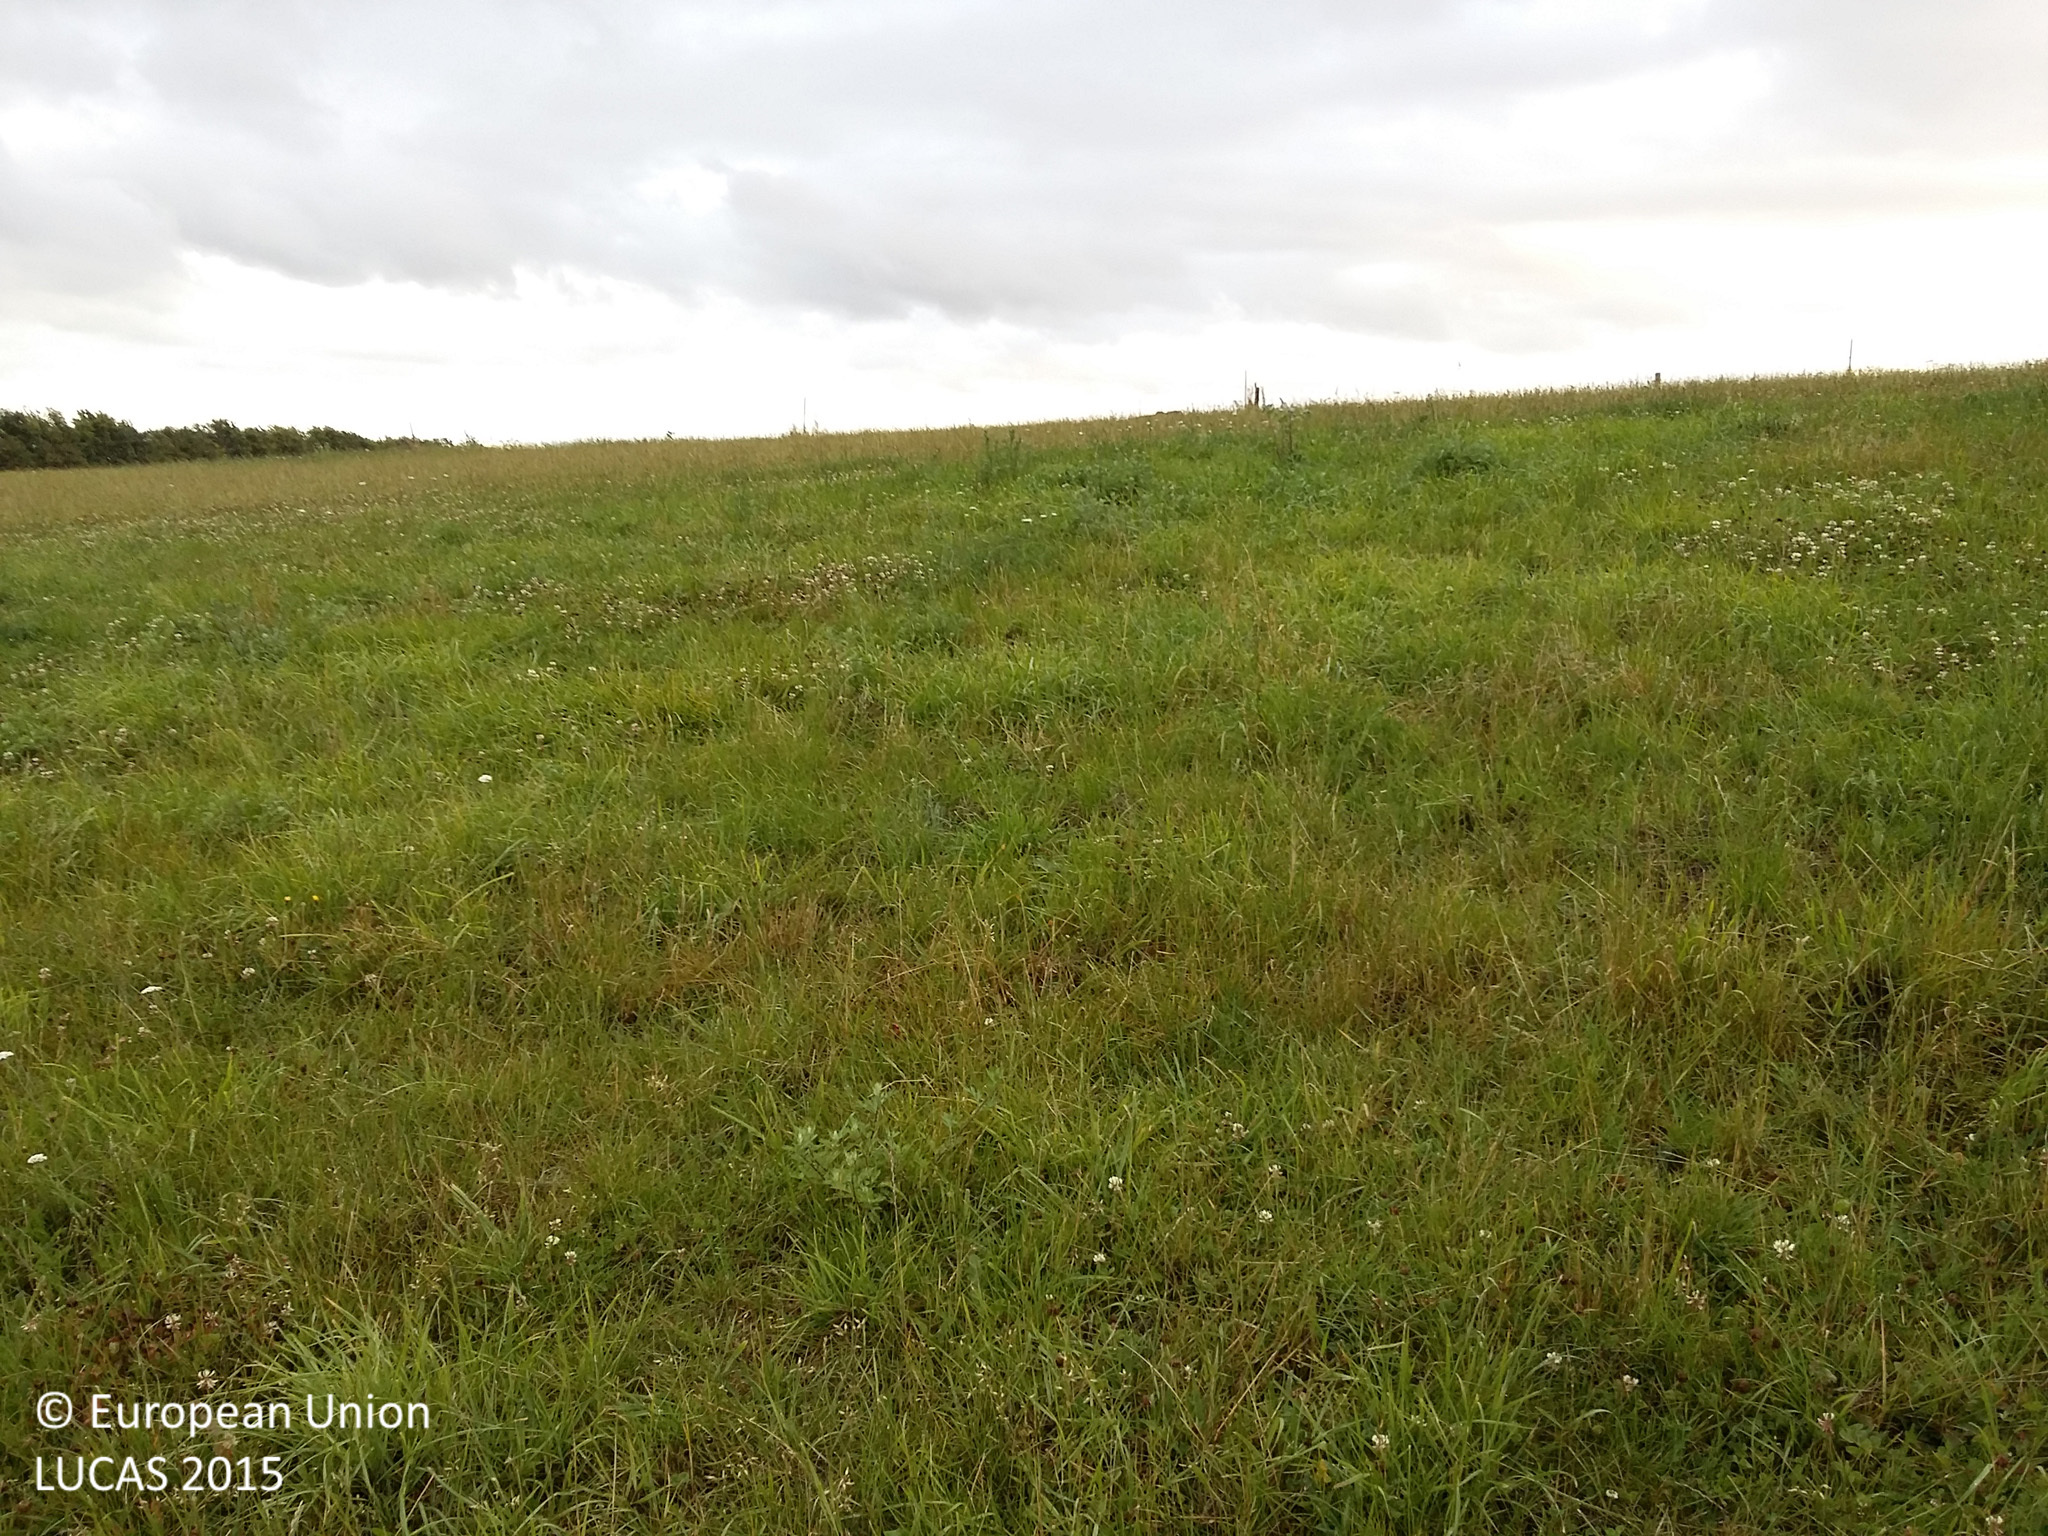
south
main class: Grassland
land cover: Grassland without tree/shrub cover
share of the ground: > 75 %
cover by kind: herbaceous plants 100 %
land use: Agriculture (excluding fallow land and kitchen gardens)
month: July
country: DK
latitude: 55.8095
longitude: 12.1841
